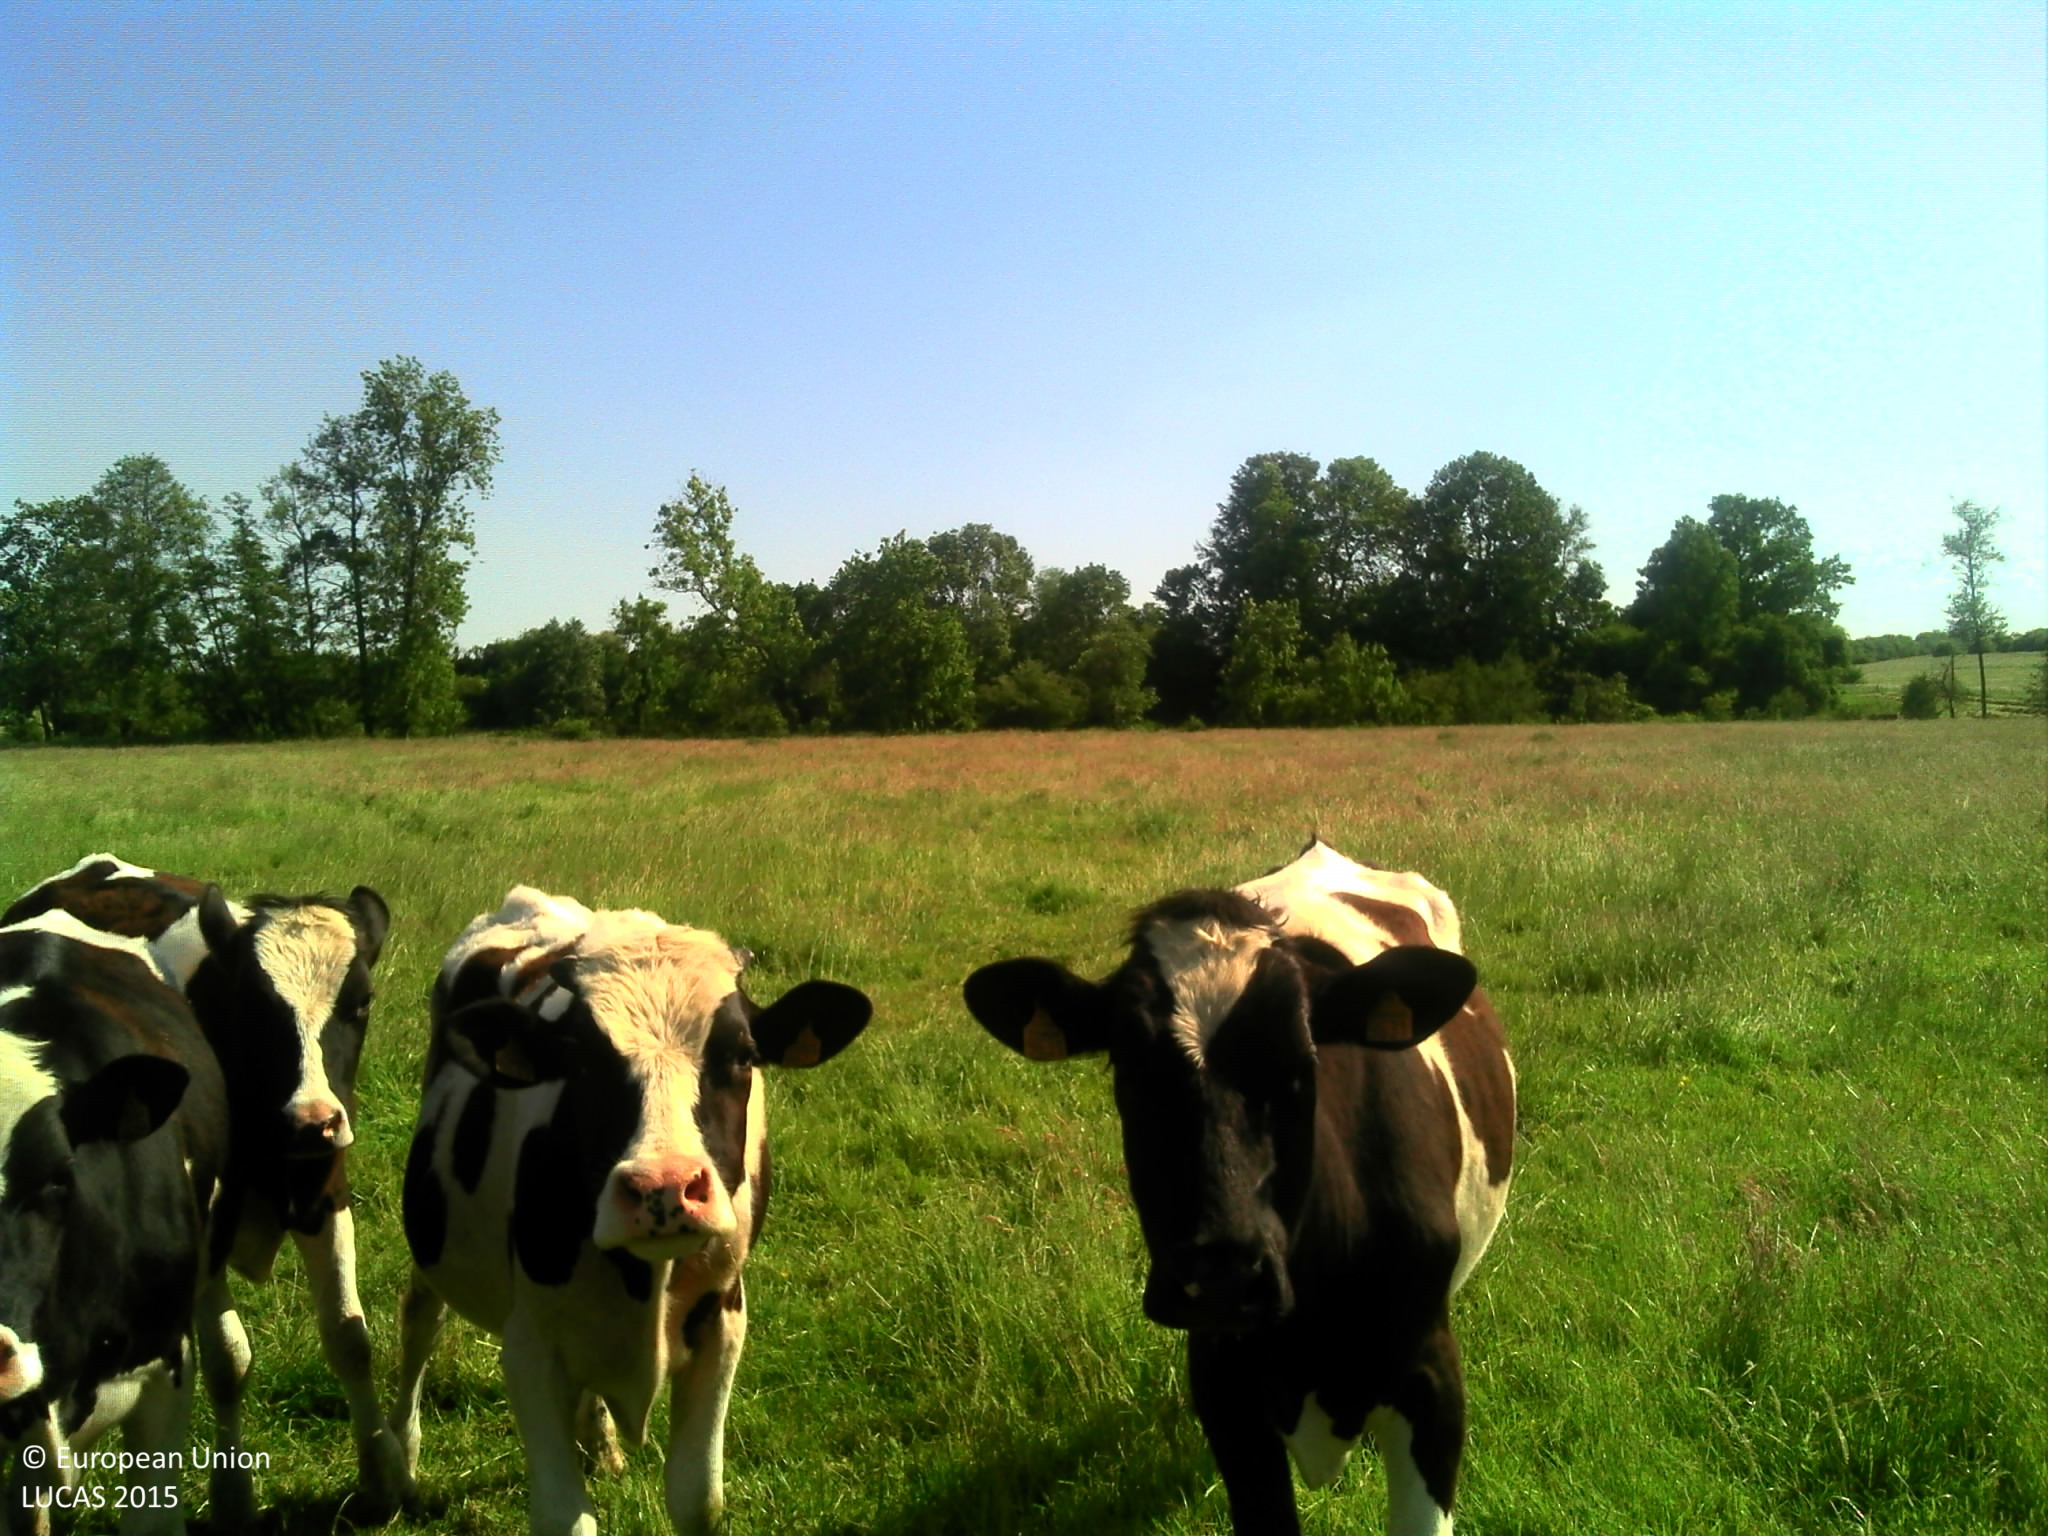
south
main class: Grassland
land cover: Grassland without tree/shrub cover
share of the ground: > 75 %
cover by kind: herbaceous plants 100 %
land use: Agriculture (excluding fallow land and kitchen gardens)
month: June
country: FR
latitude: 49.8697
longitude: 4.1095
